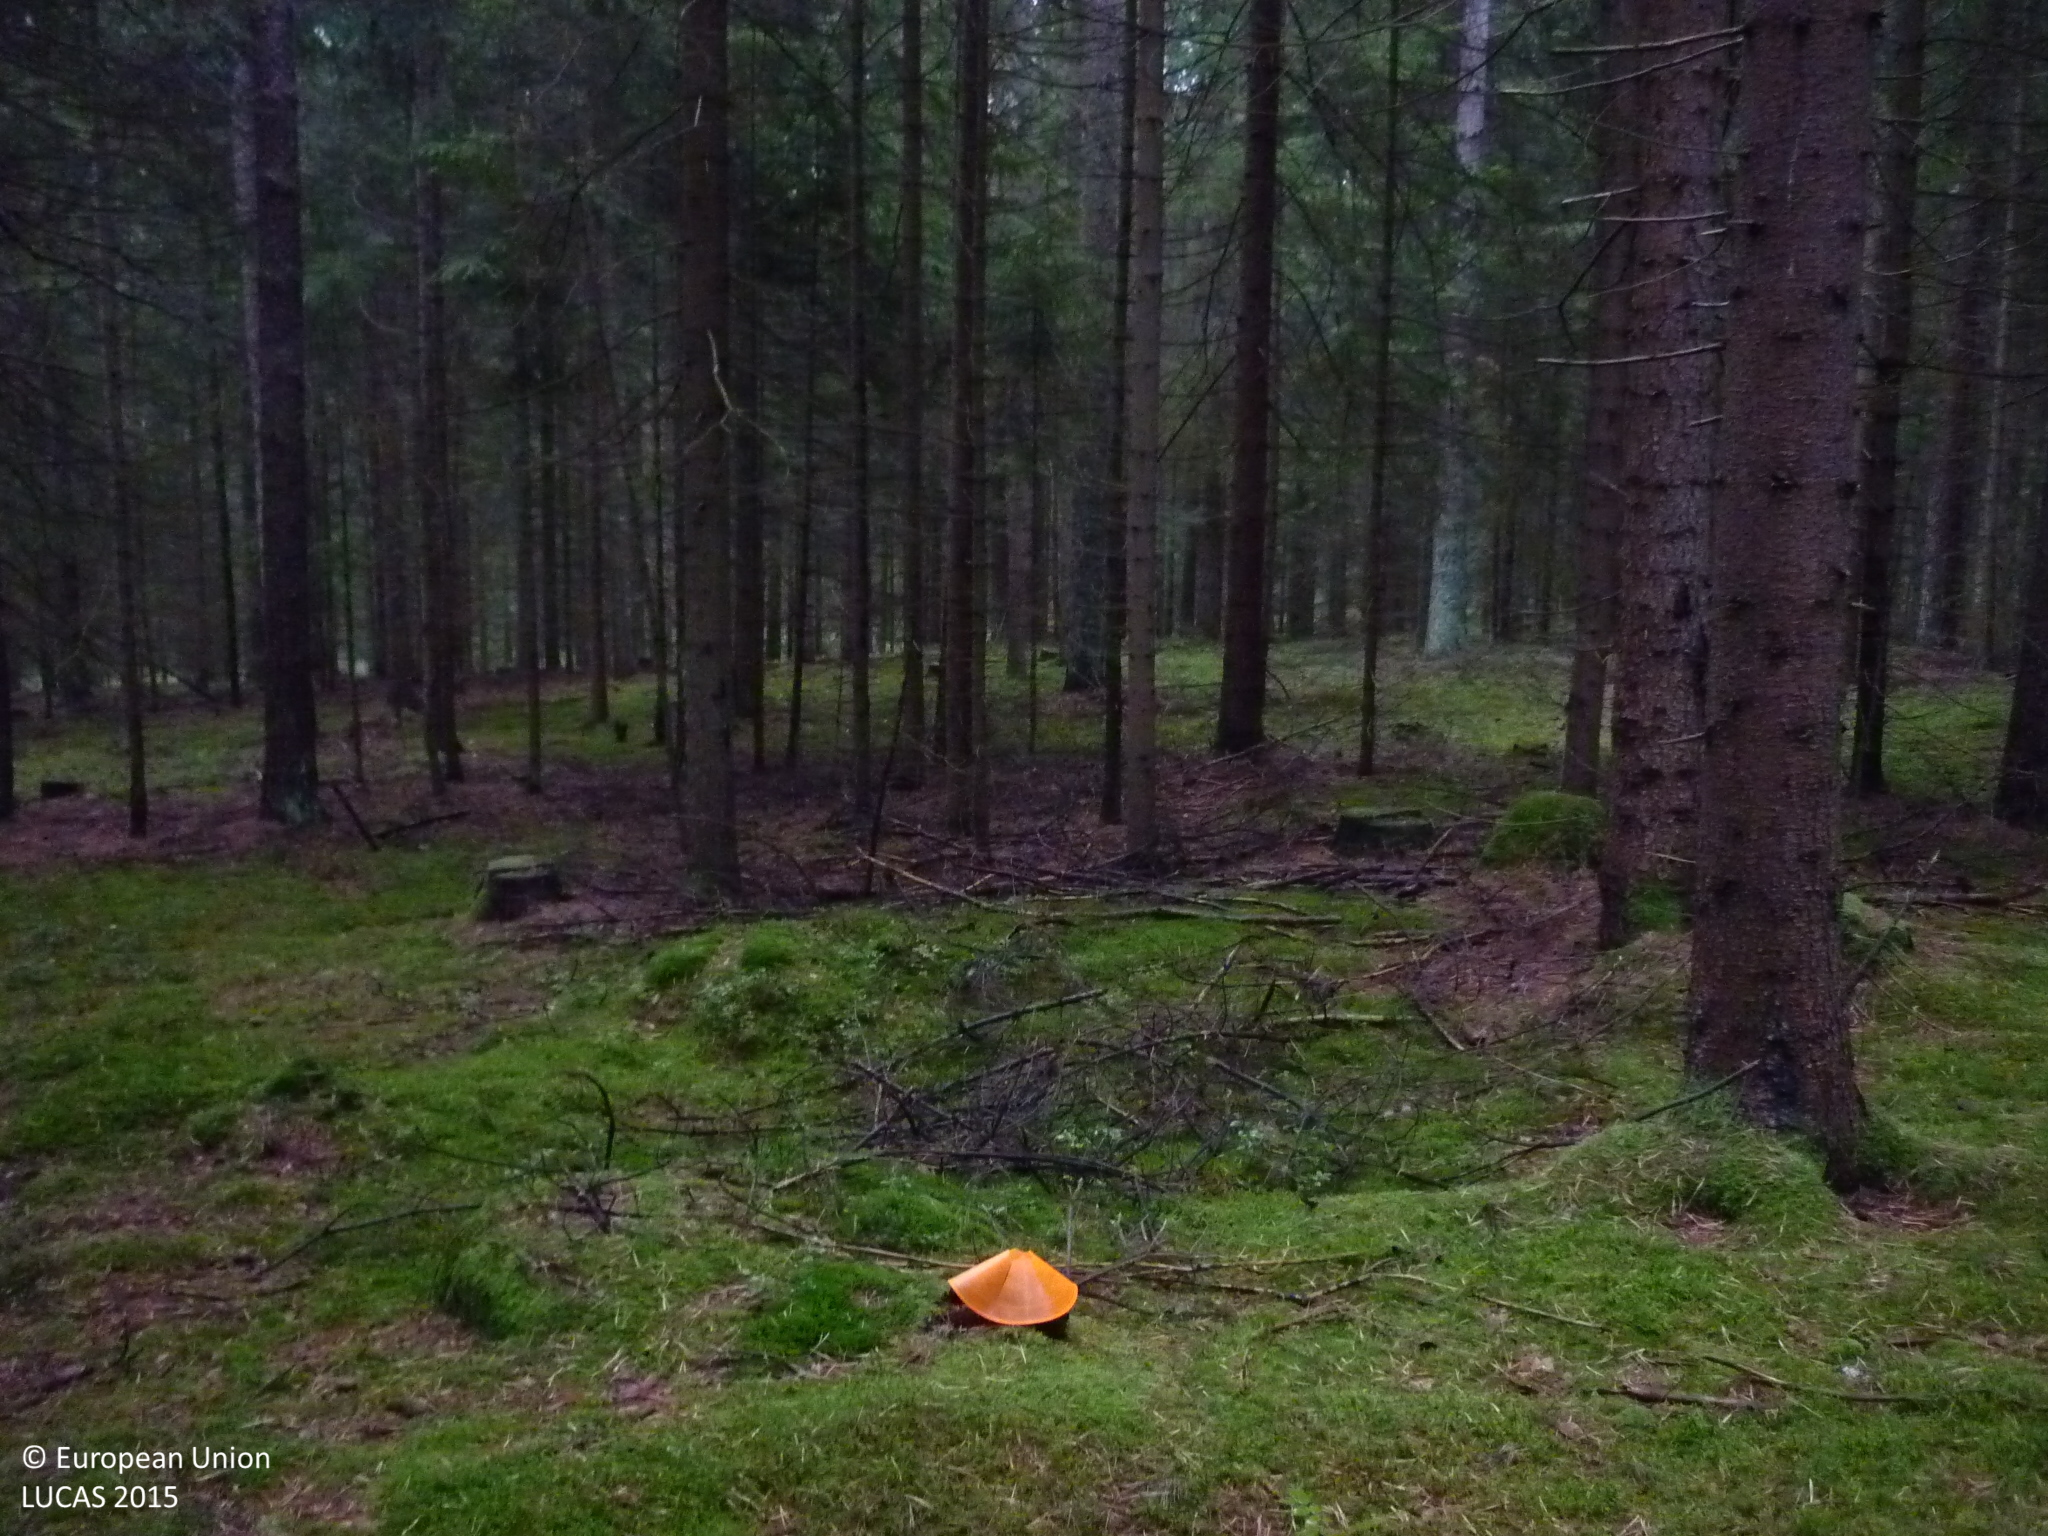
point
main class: Woodland
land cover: Spruce dominated coniferous woodland
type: hemiboreal forest and nemoral coniferous forest and mixed broadleaved-coniferous forest
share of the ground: > 75 %
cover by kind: coniferous forest trees 90 %, lichens and mosses 10 %
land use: Forestry
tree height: > 5 m
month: September
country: AT
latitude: 48.9184
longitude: 15.0650
